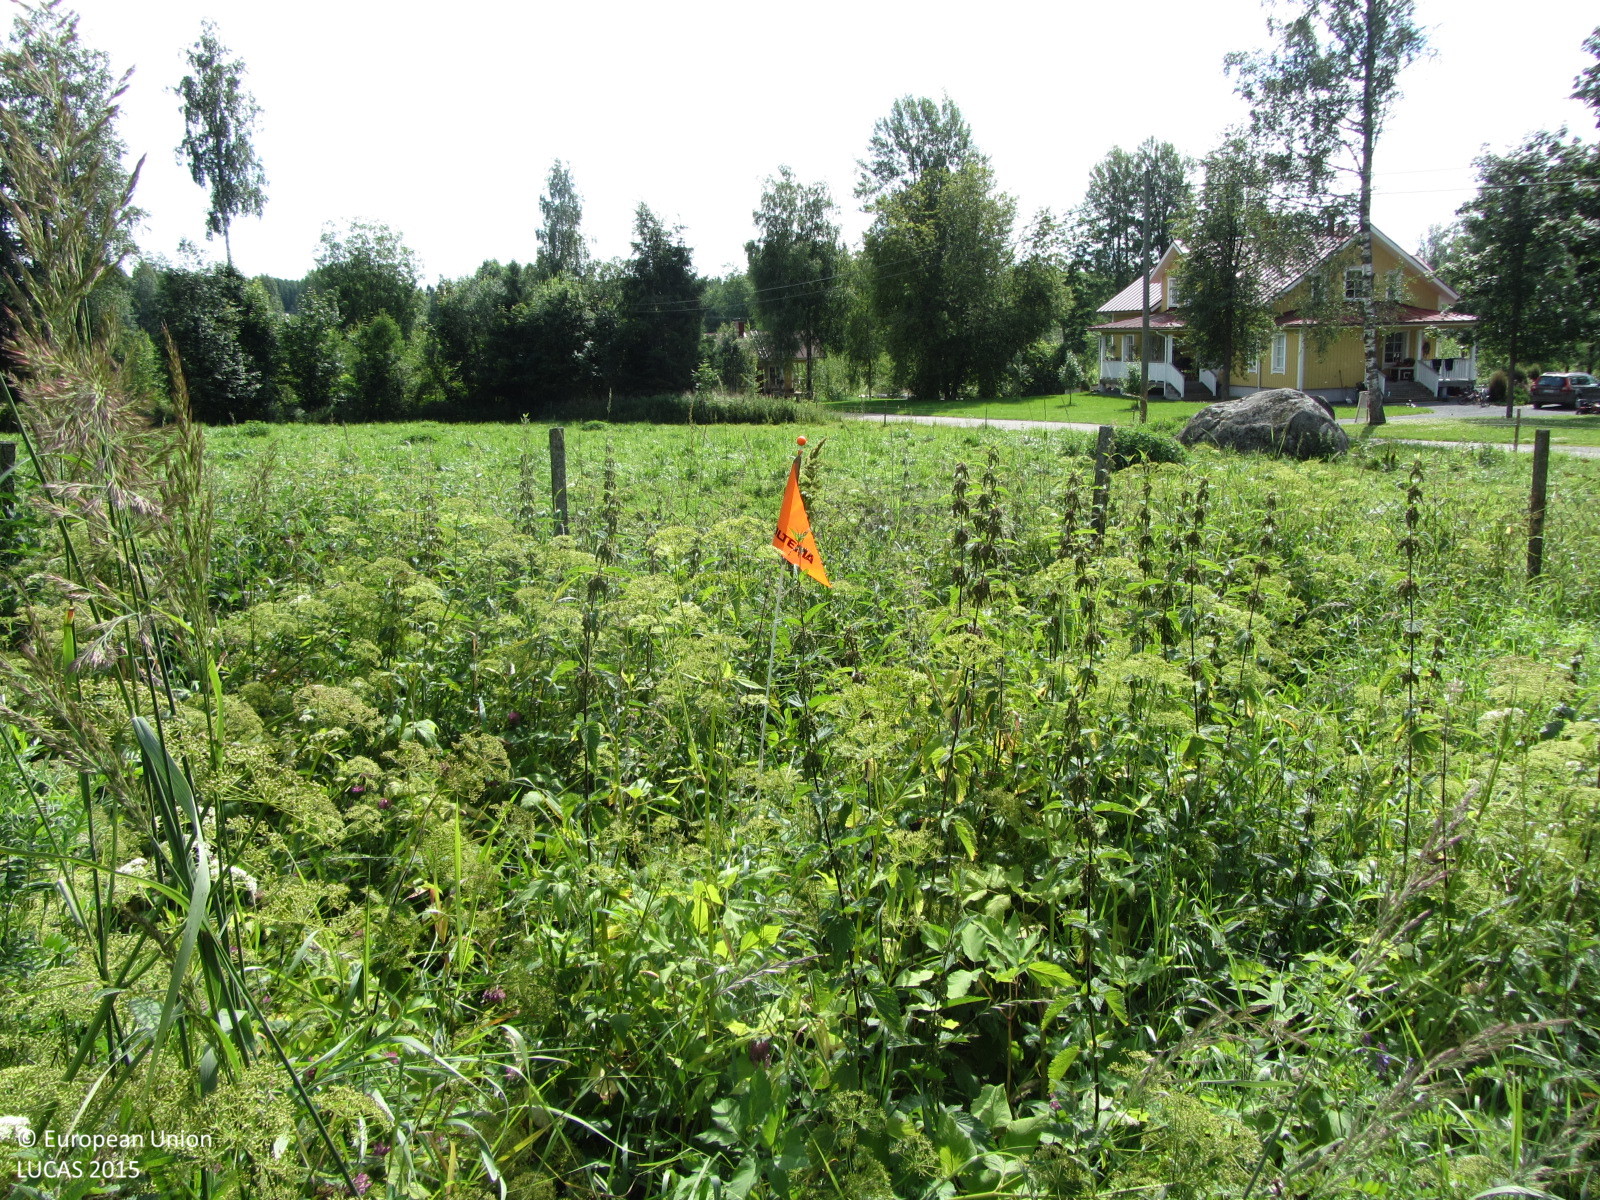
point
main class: Cropland
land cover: Other fruit trees and berries
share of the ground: 50 - 75 %
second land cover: Apple fruit
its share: 25 - 50 %
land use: Kitchen garden
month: July
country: FI
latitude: 60.5887
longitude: 24.4348
